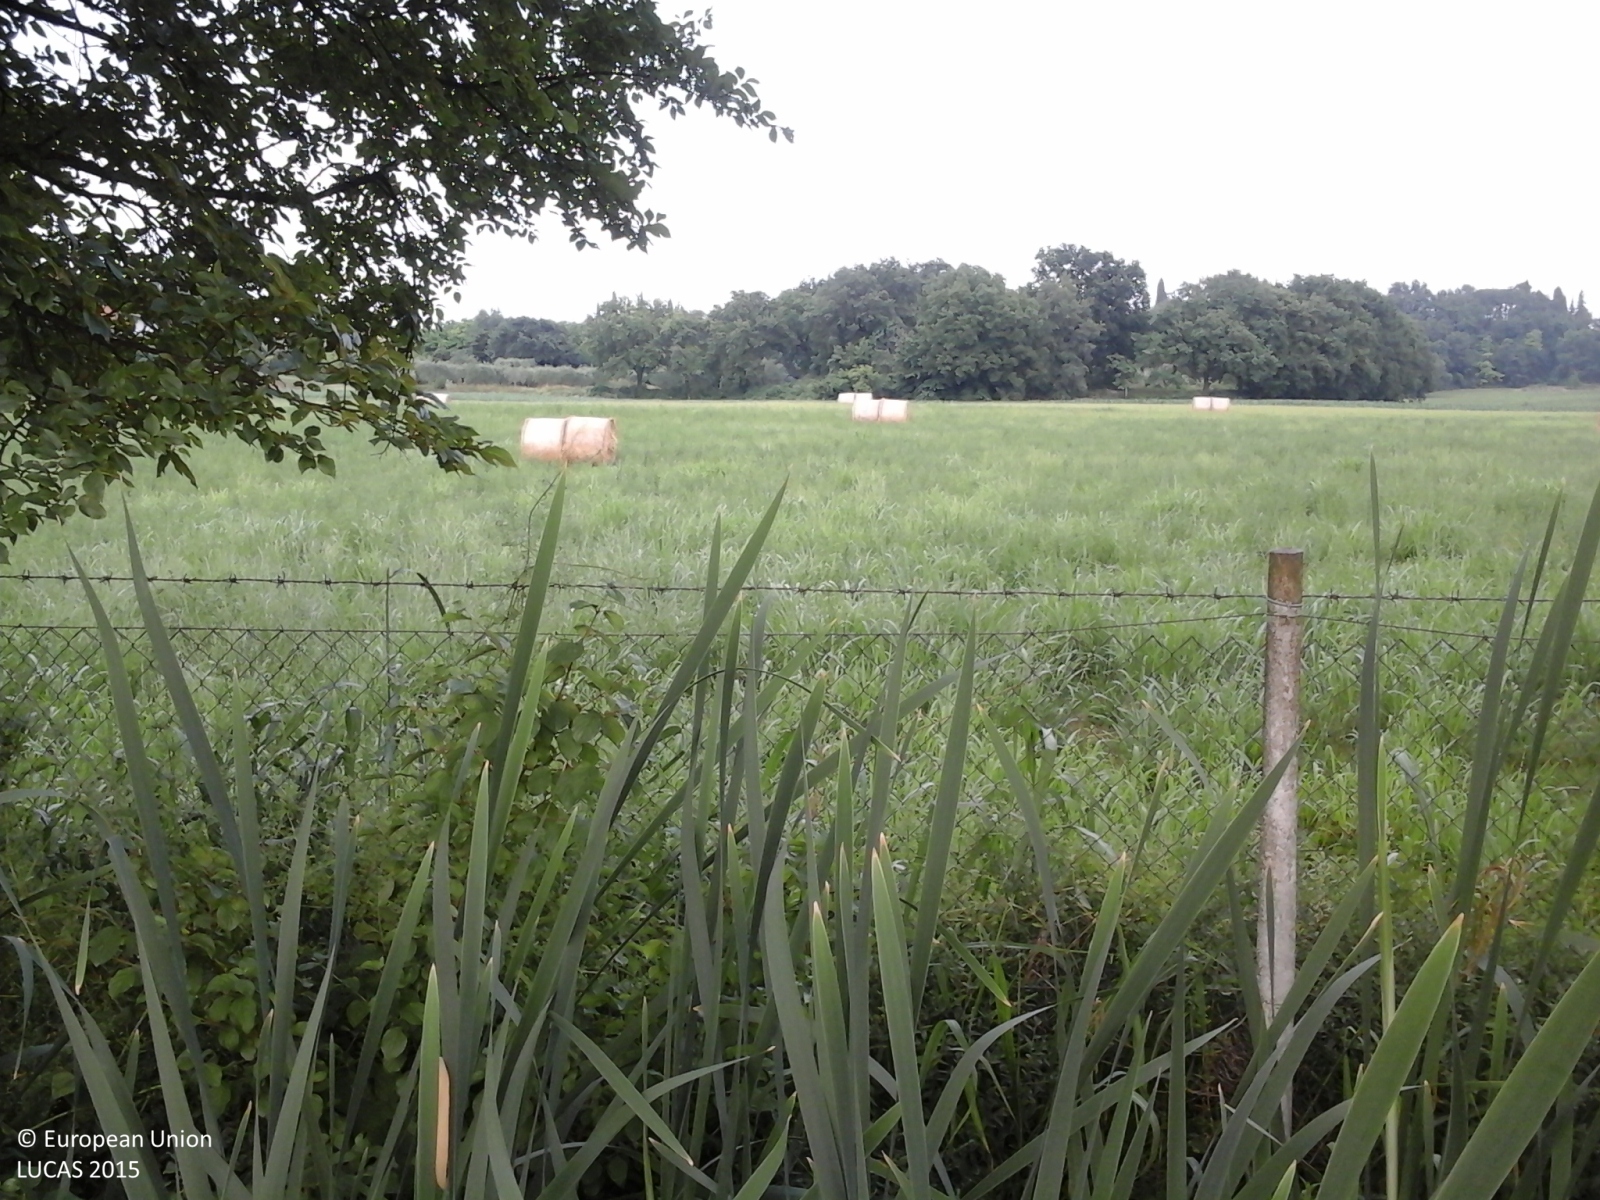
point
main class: Grassland
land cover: Grassland without tree/shrub cover
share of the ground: > 75 %
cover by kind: herbaceous plants 100 %
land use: Agriculture (excluding fallow land and kitchen gardens)
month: June
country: IT
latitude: 45.4837
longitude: 10.7536
